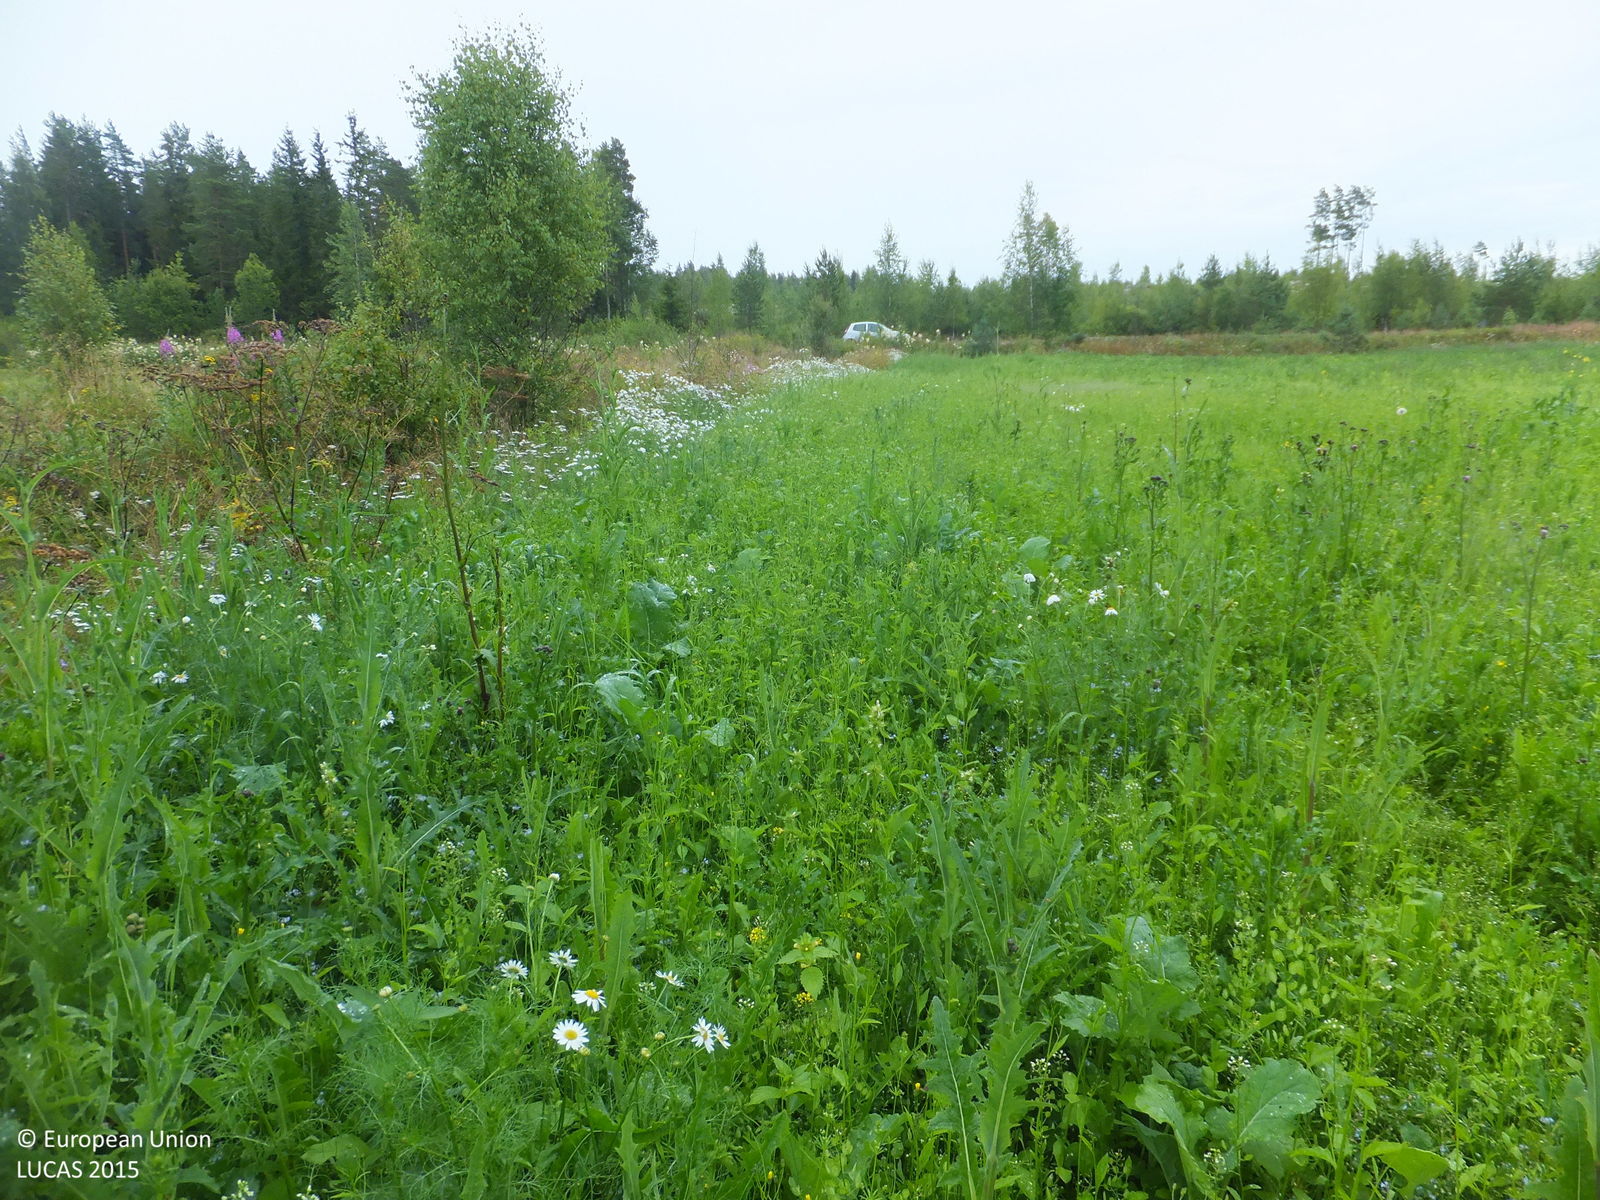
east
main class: Grassland
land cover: Grassland without tree/shrub cover
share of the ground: > 75 %
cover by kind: herbaceous plants 95 %, shrubs 5 %
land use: Agriculture (excluding fallow land and kitchen gardens)
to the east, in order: Grassland without tree/shrub cover; Grass margins; Ditches and canals; Grass margins; Tracks; Grass margins; Temporary grasslands; Ditches and canals; Shruby margins; Tracks; Shruby margins; Ditches and canals; Other coniferous woodland; Shrubland without tree cover; Broadleaved woodland
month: July
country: FI
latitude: 63.0764
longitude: 22.0611
